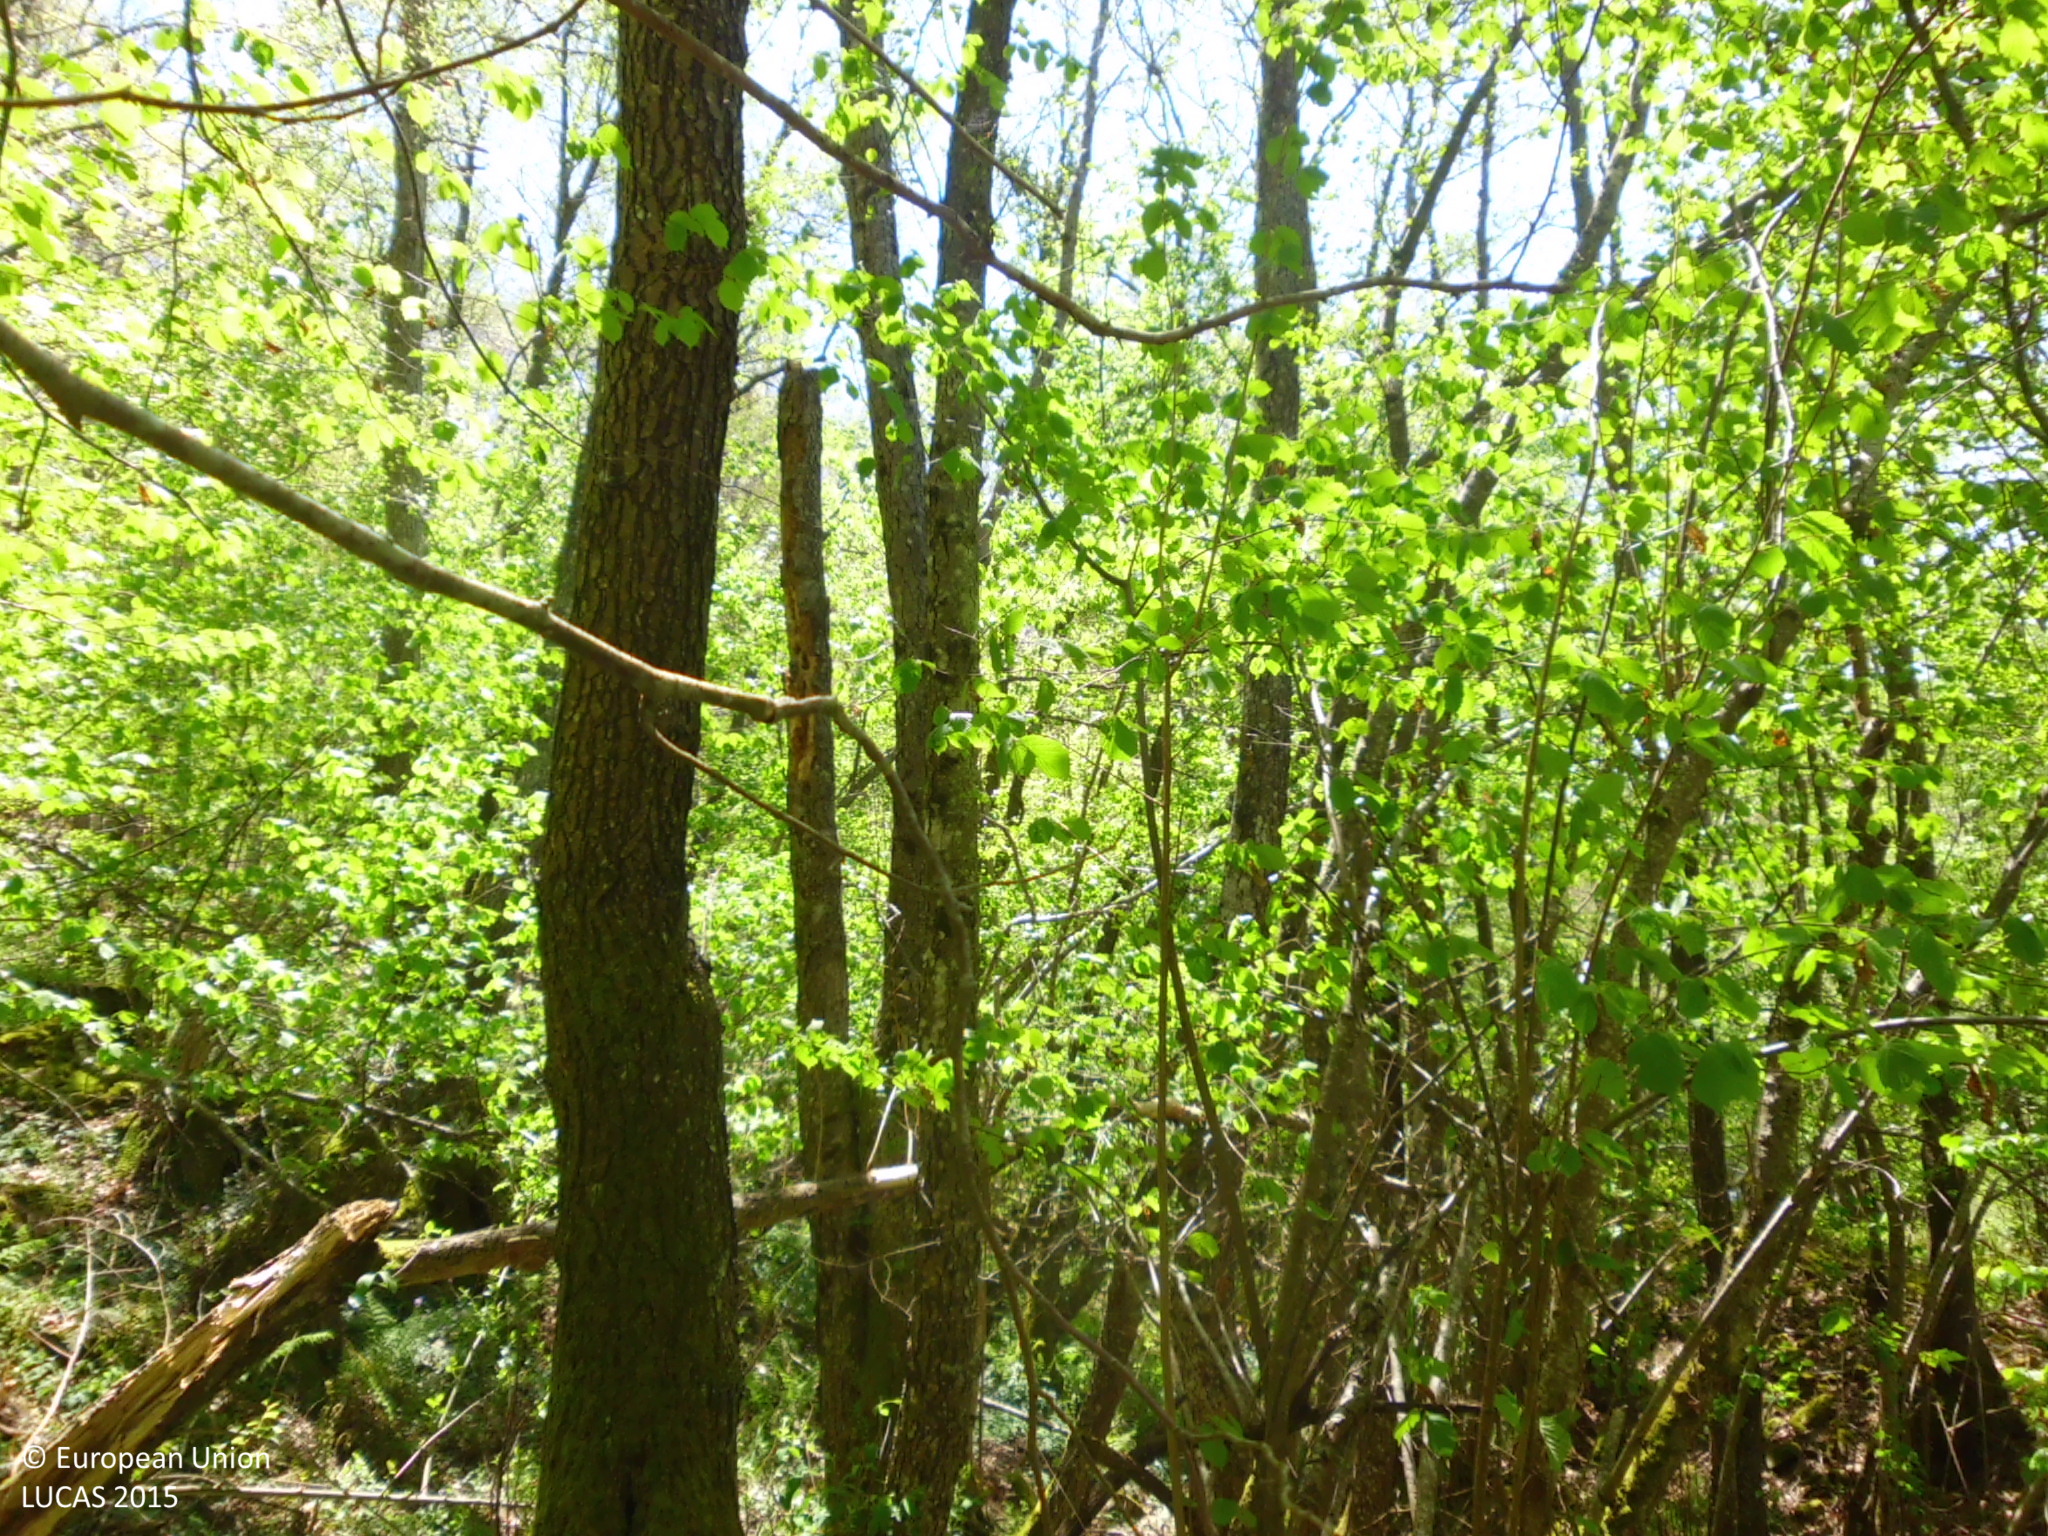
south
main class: Woodland
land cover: Broadleaved woodland
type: acidophilous oak and oak-birch forest
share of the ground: > 75 %
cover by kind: broadleaved forest trees 90 %, shrubs 5 %, herbaceous plants 5 %
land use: Semi-natural and natural areas not in use
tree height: > 5 m
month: May
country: ES
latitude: 42.9171
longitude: -4.0249
